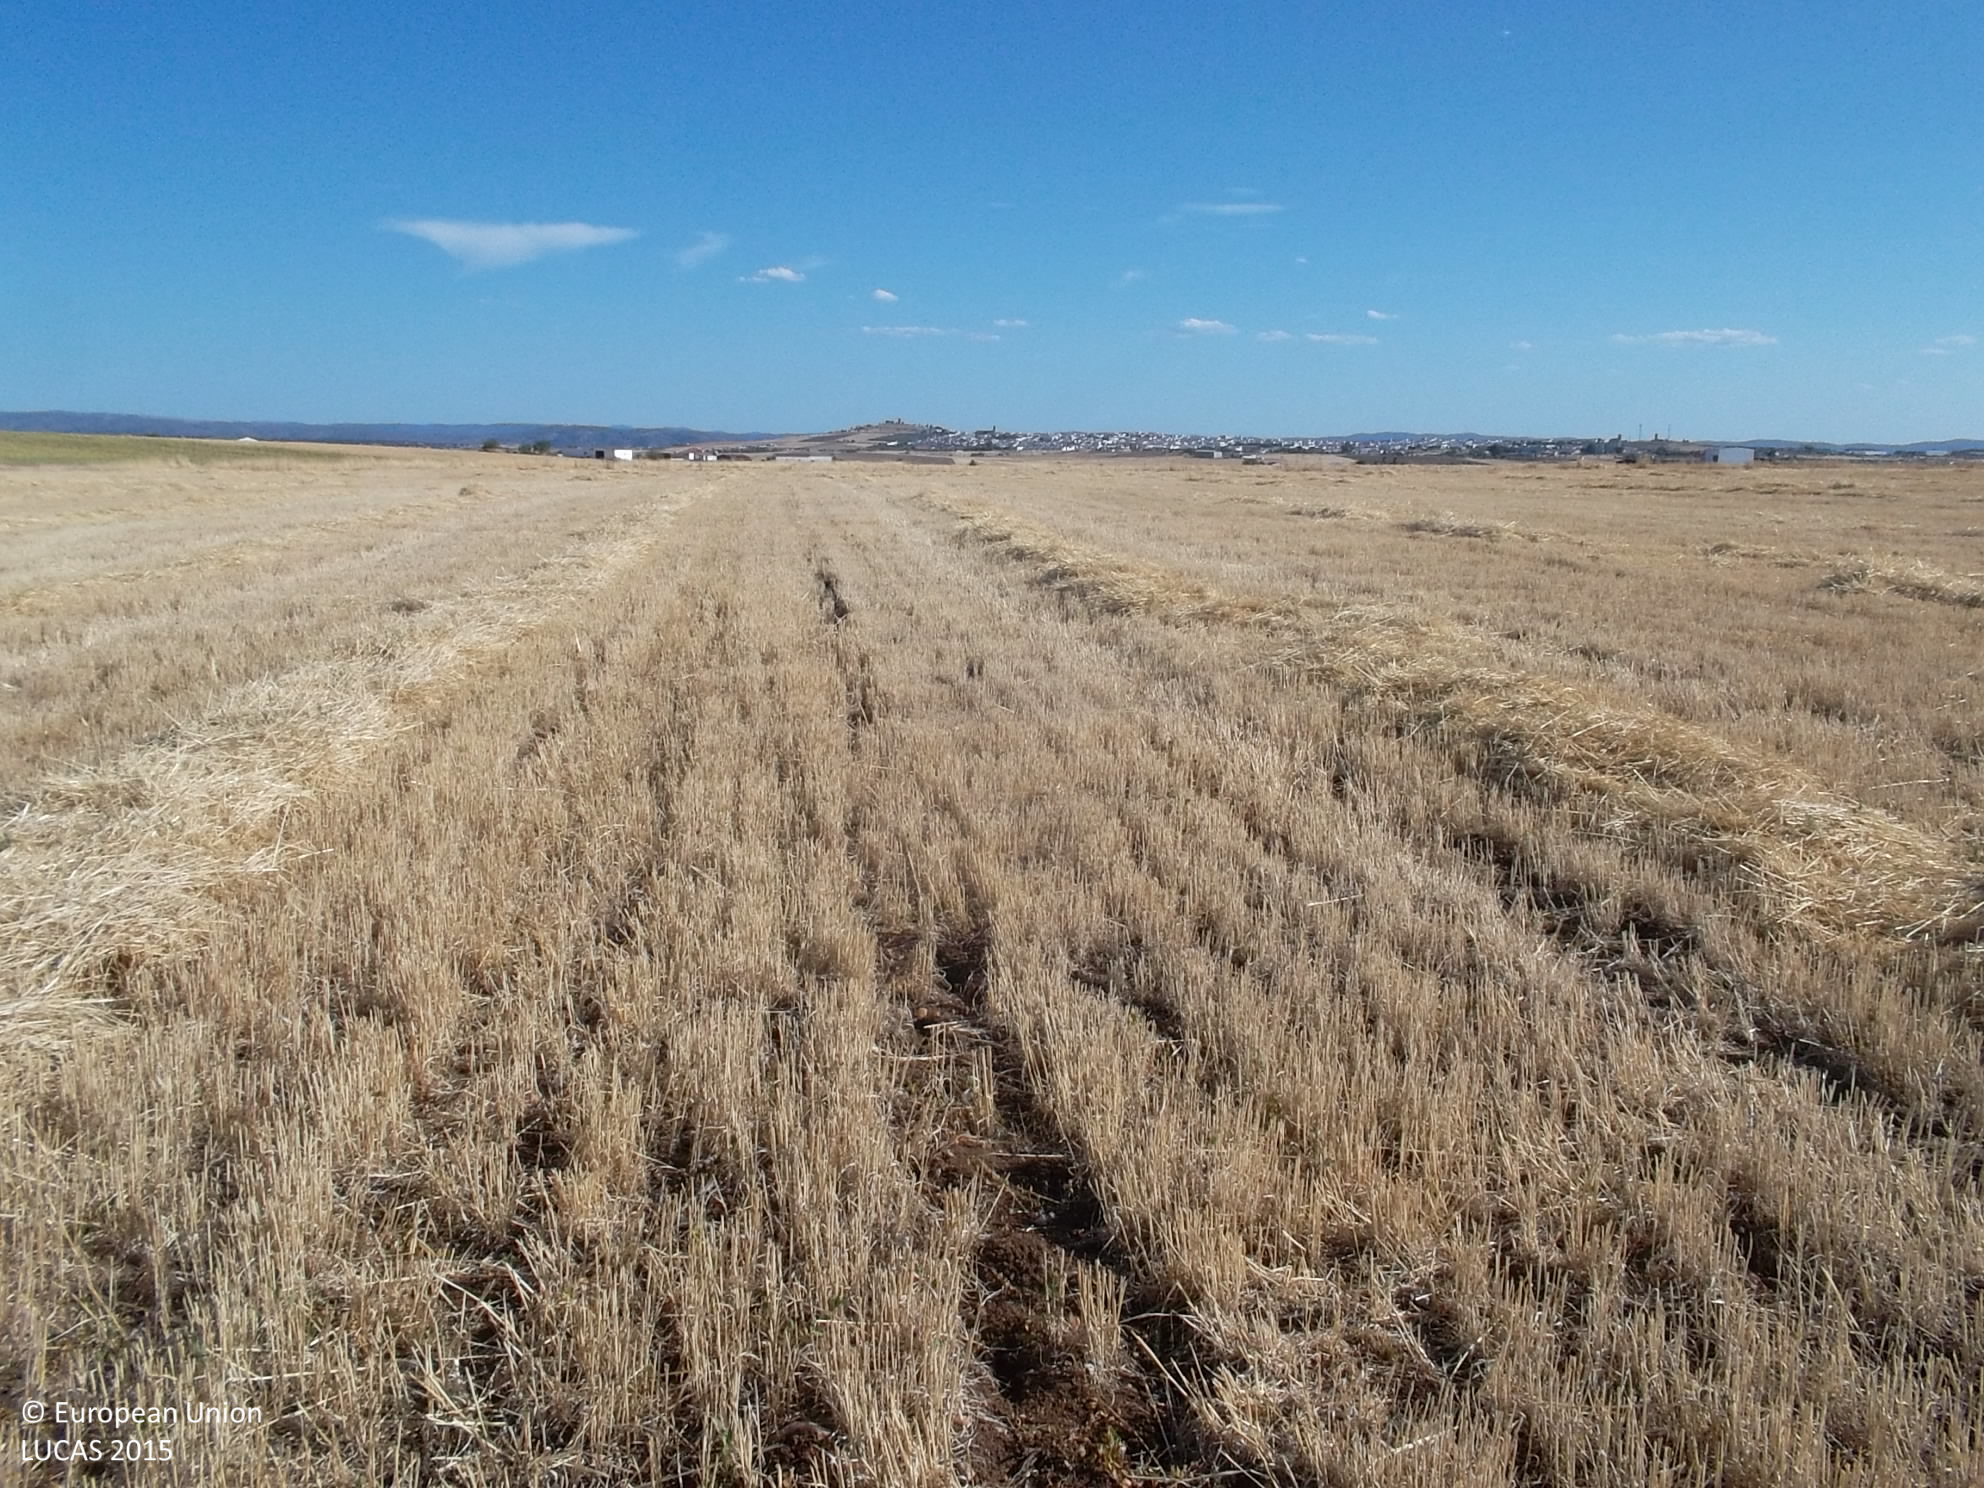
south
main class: Cropland
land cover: Barley
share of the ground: < 10 %
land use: Agriculture (excluding fallow land and kitchen gardens)
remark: Harvested field
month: July
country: ES
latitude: 38.3008
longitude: -5.6663
